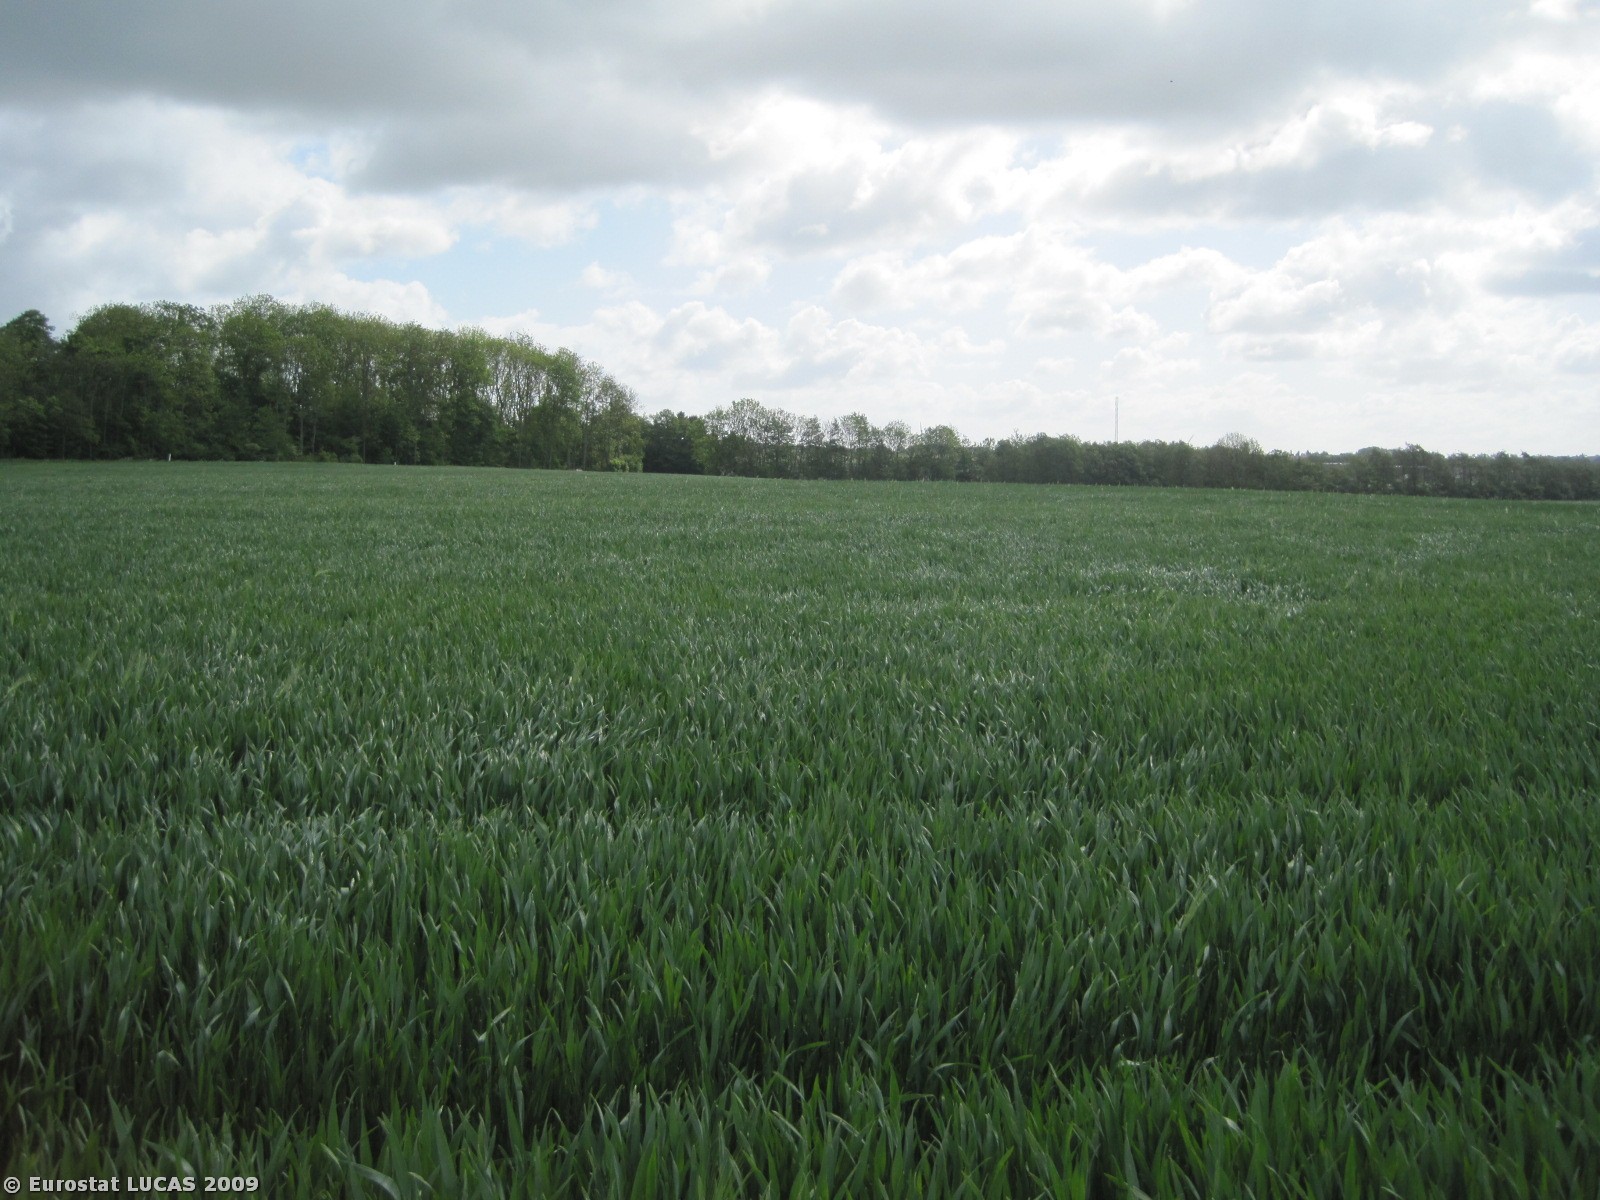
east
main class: Cropland
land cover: Common wheat
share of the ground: > 75 %
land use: Agriculture (excluding fallow land and kitchen gardens)
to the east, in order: Common wheat
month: May
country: DK
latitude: 56.5473
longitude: 10.0162
